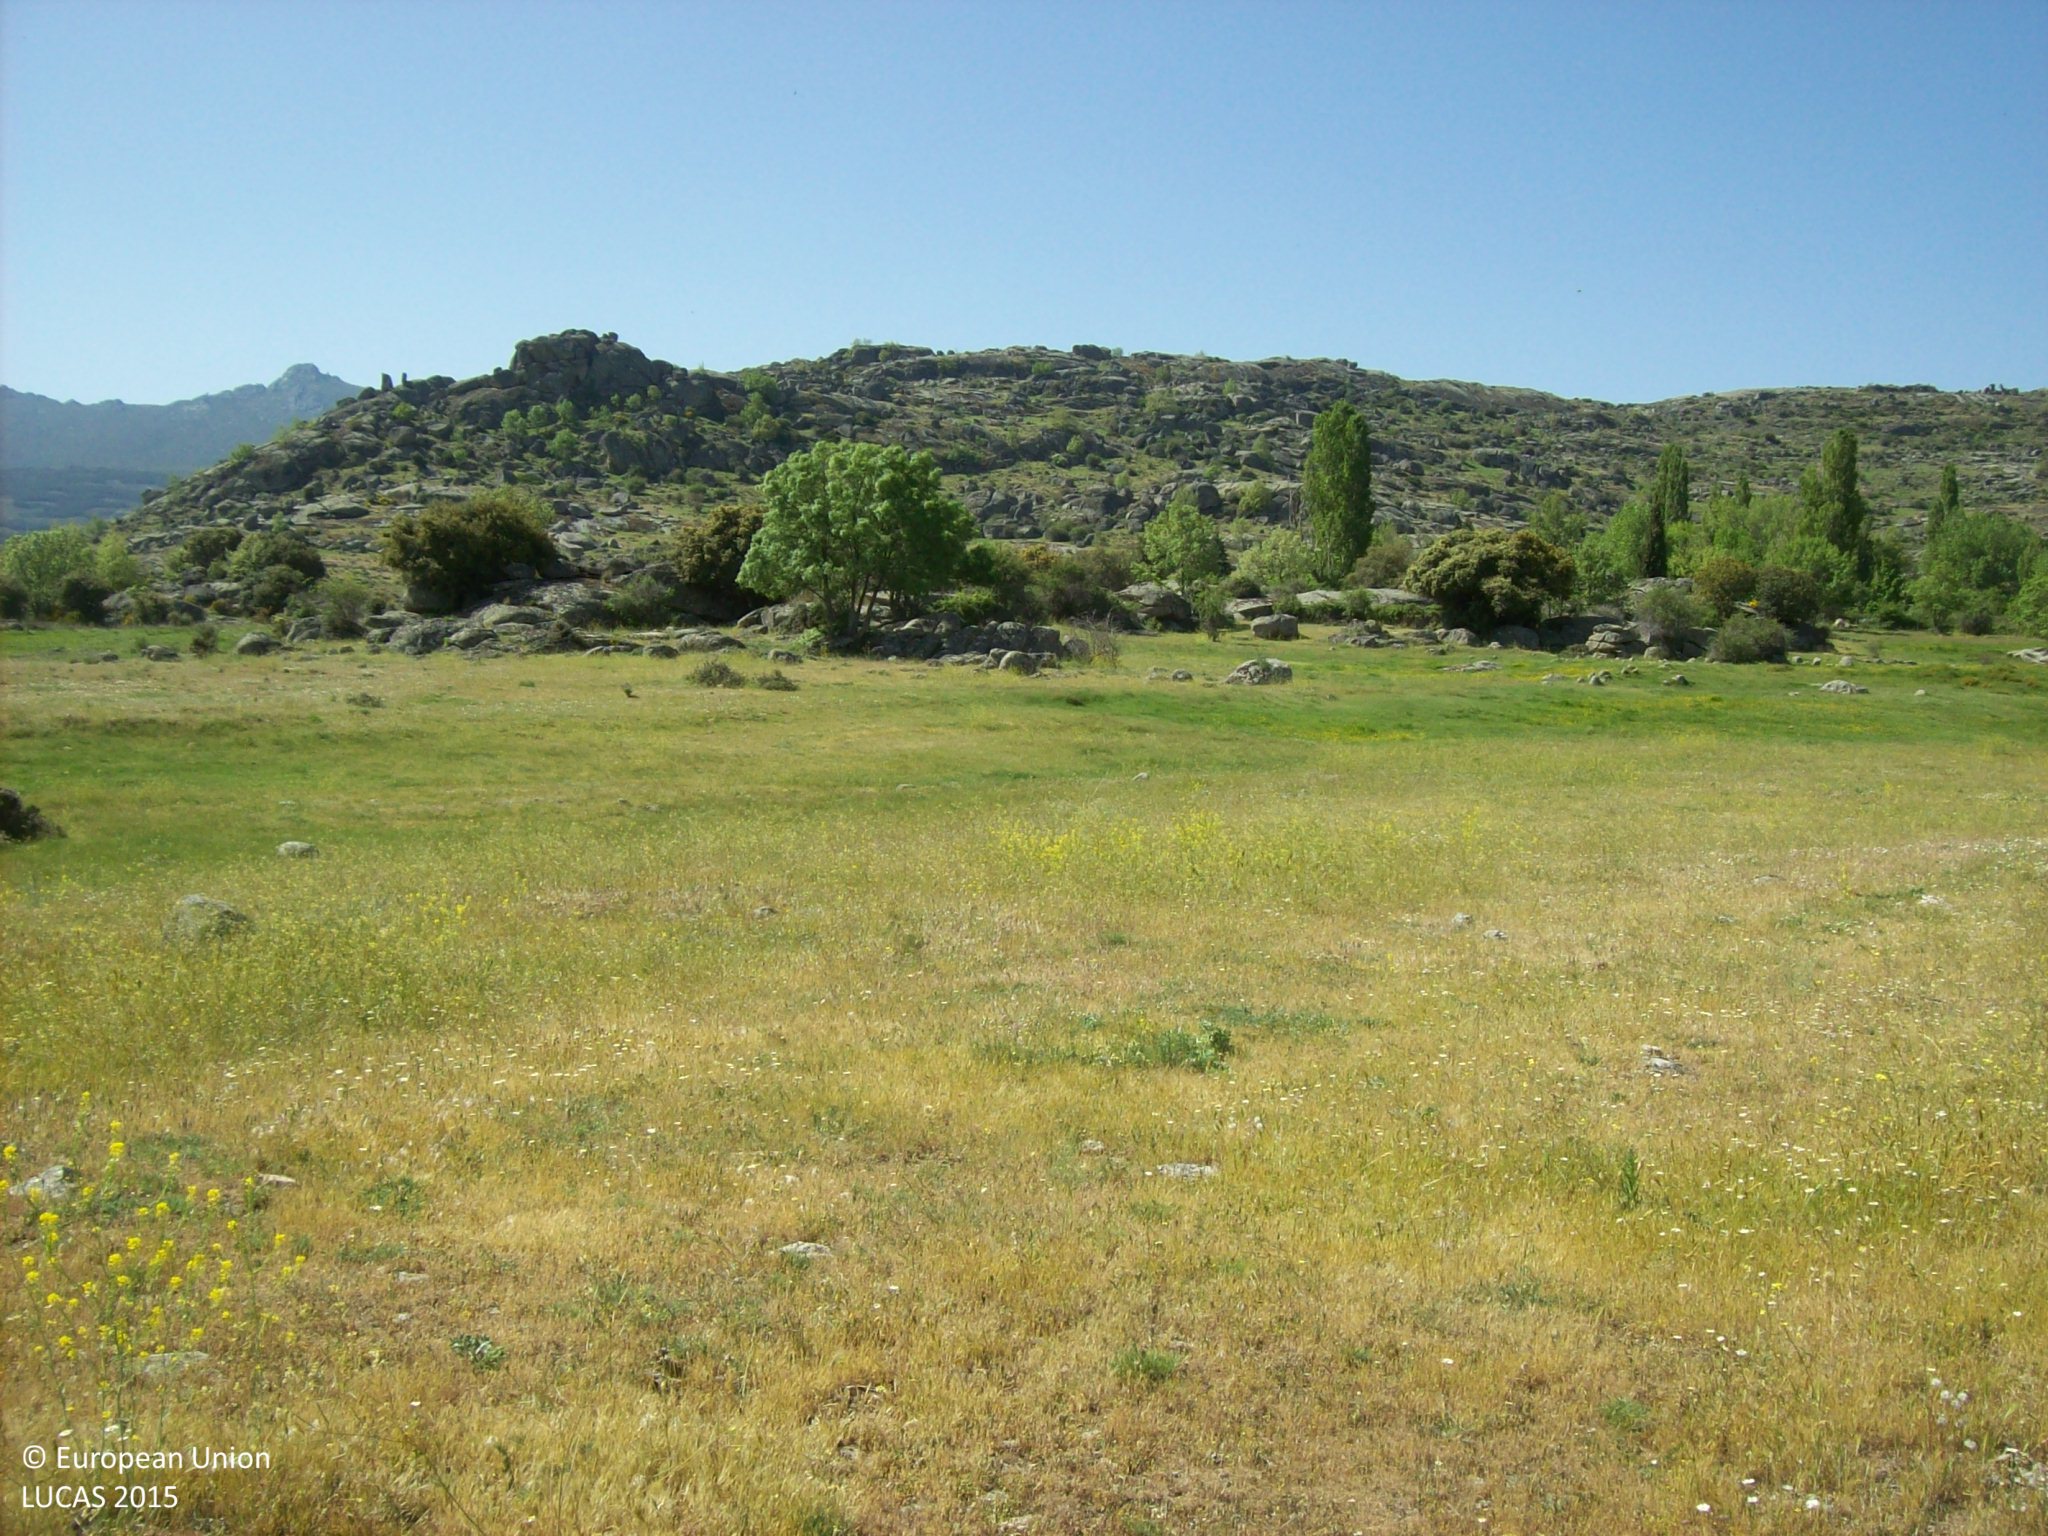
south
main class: Grassland
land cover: Grassland without tree/shrub cover
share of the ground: > 75 %
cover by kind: herbaceous plants 95 %, shrubs 5 %
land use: Agriculture (excluding fallow land and kitchen gardens)
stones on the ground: < 10 %
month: May
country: ES
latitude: 40.5399
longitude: -4.8743
